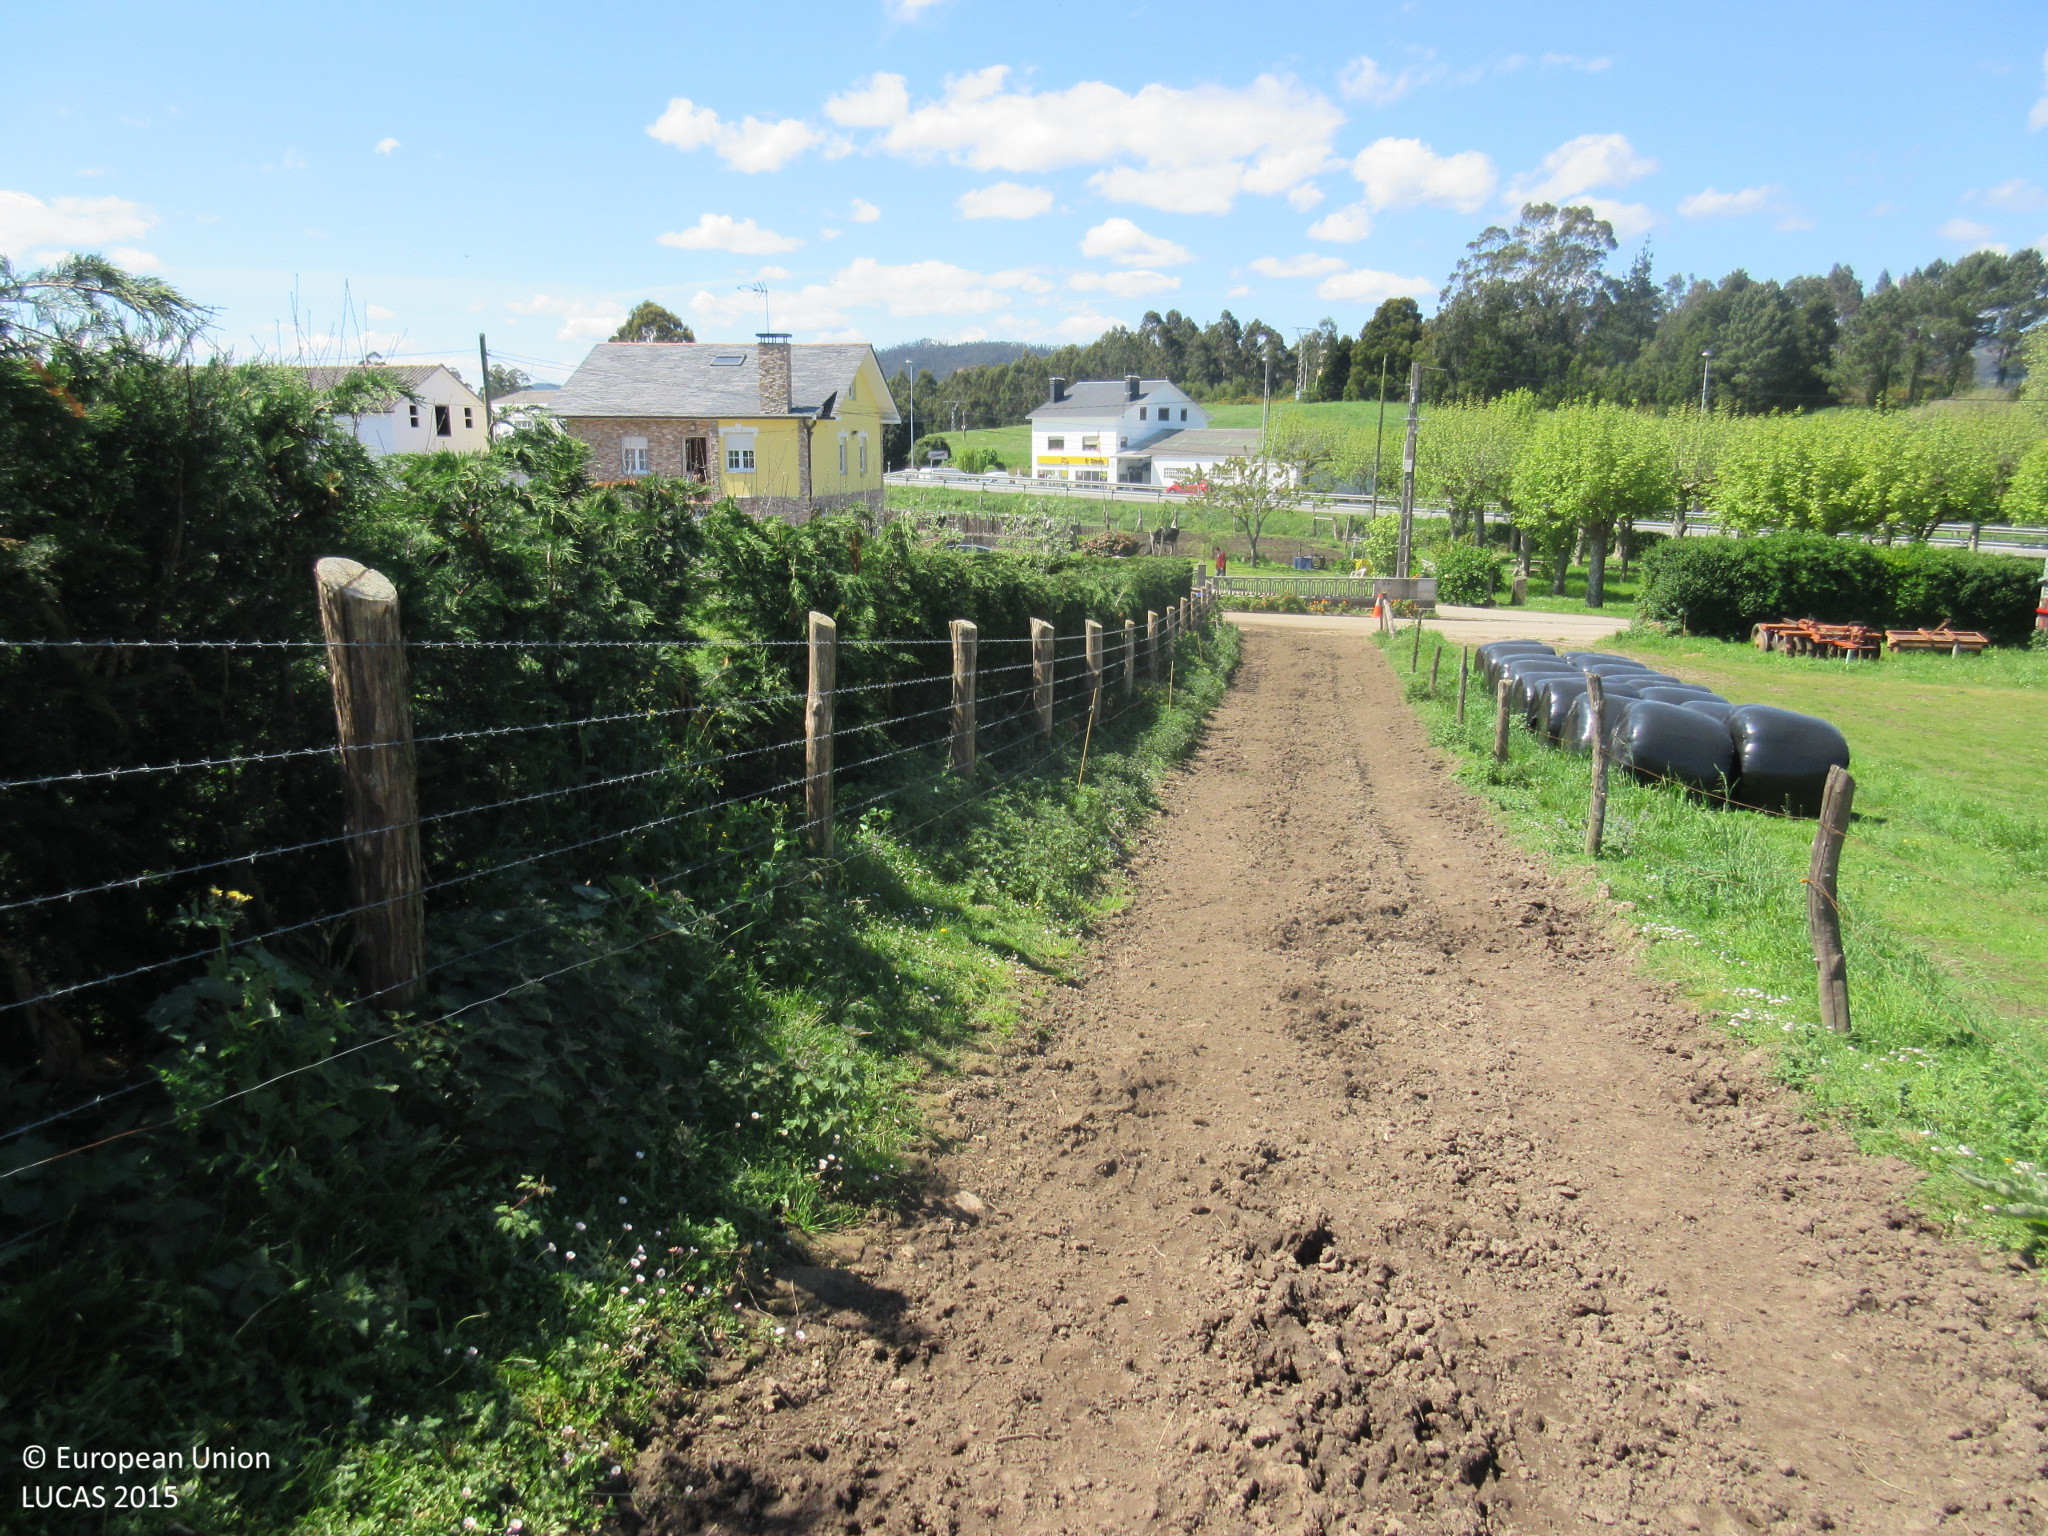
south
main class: Grassland
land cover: Grassland without tree/shrub cover
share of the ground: > 75 %
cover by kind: herbaceous plants 100 %
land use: Agriculture (excluding fallow land and kitchen gardens)
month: April
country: ES
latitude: 43.5191
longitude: -7.0301
